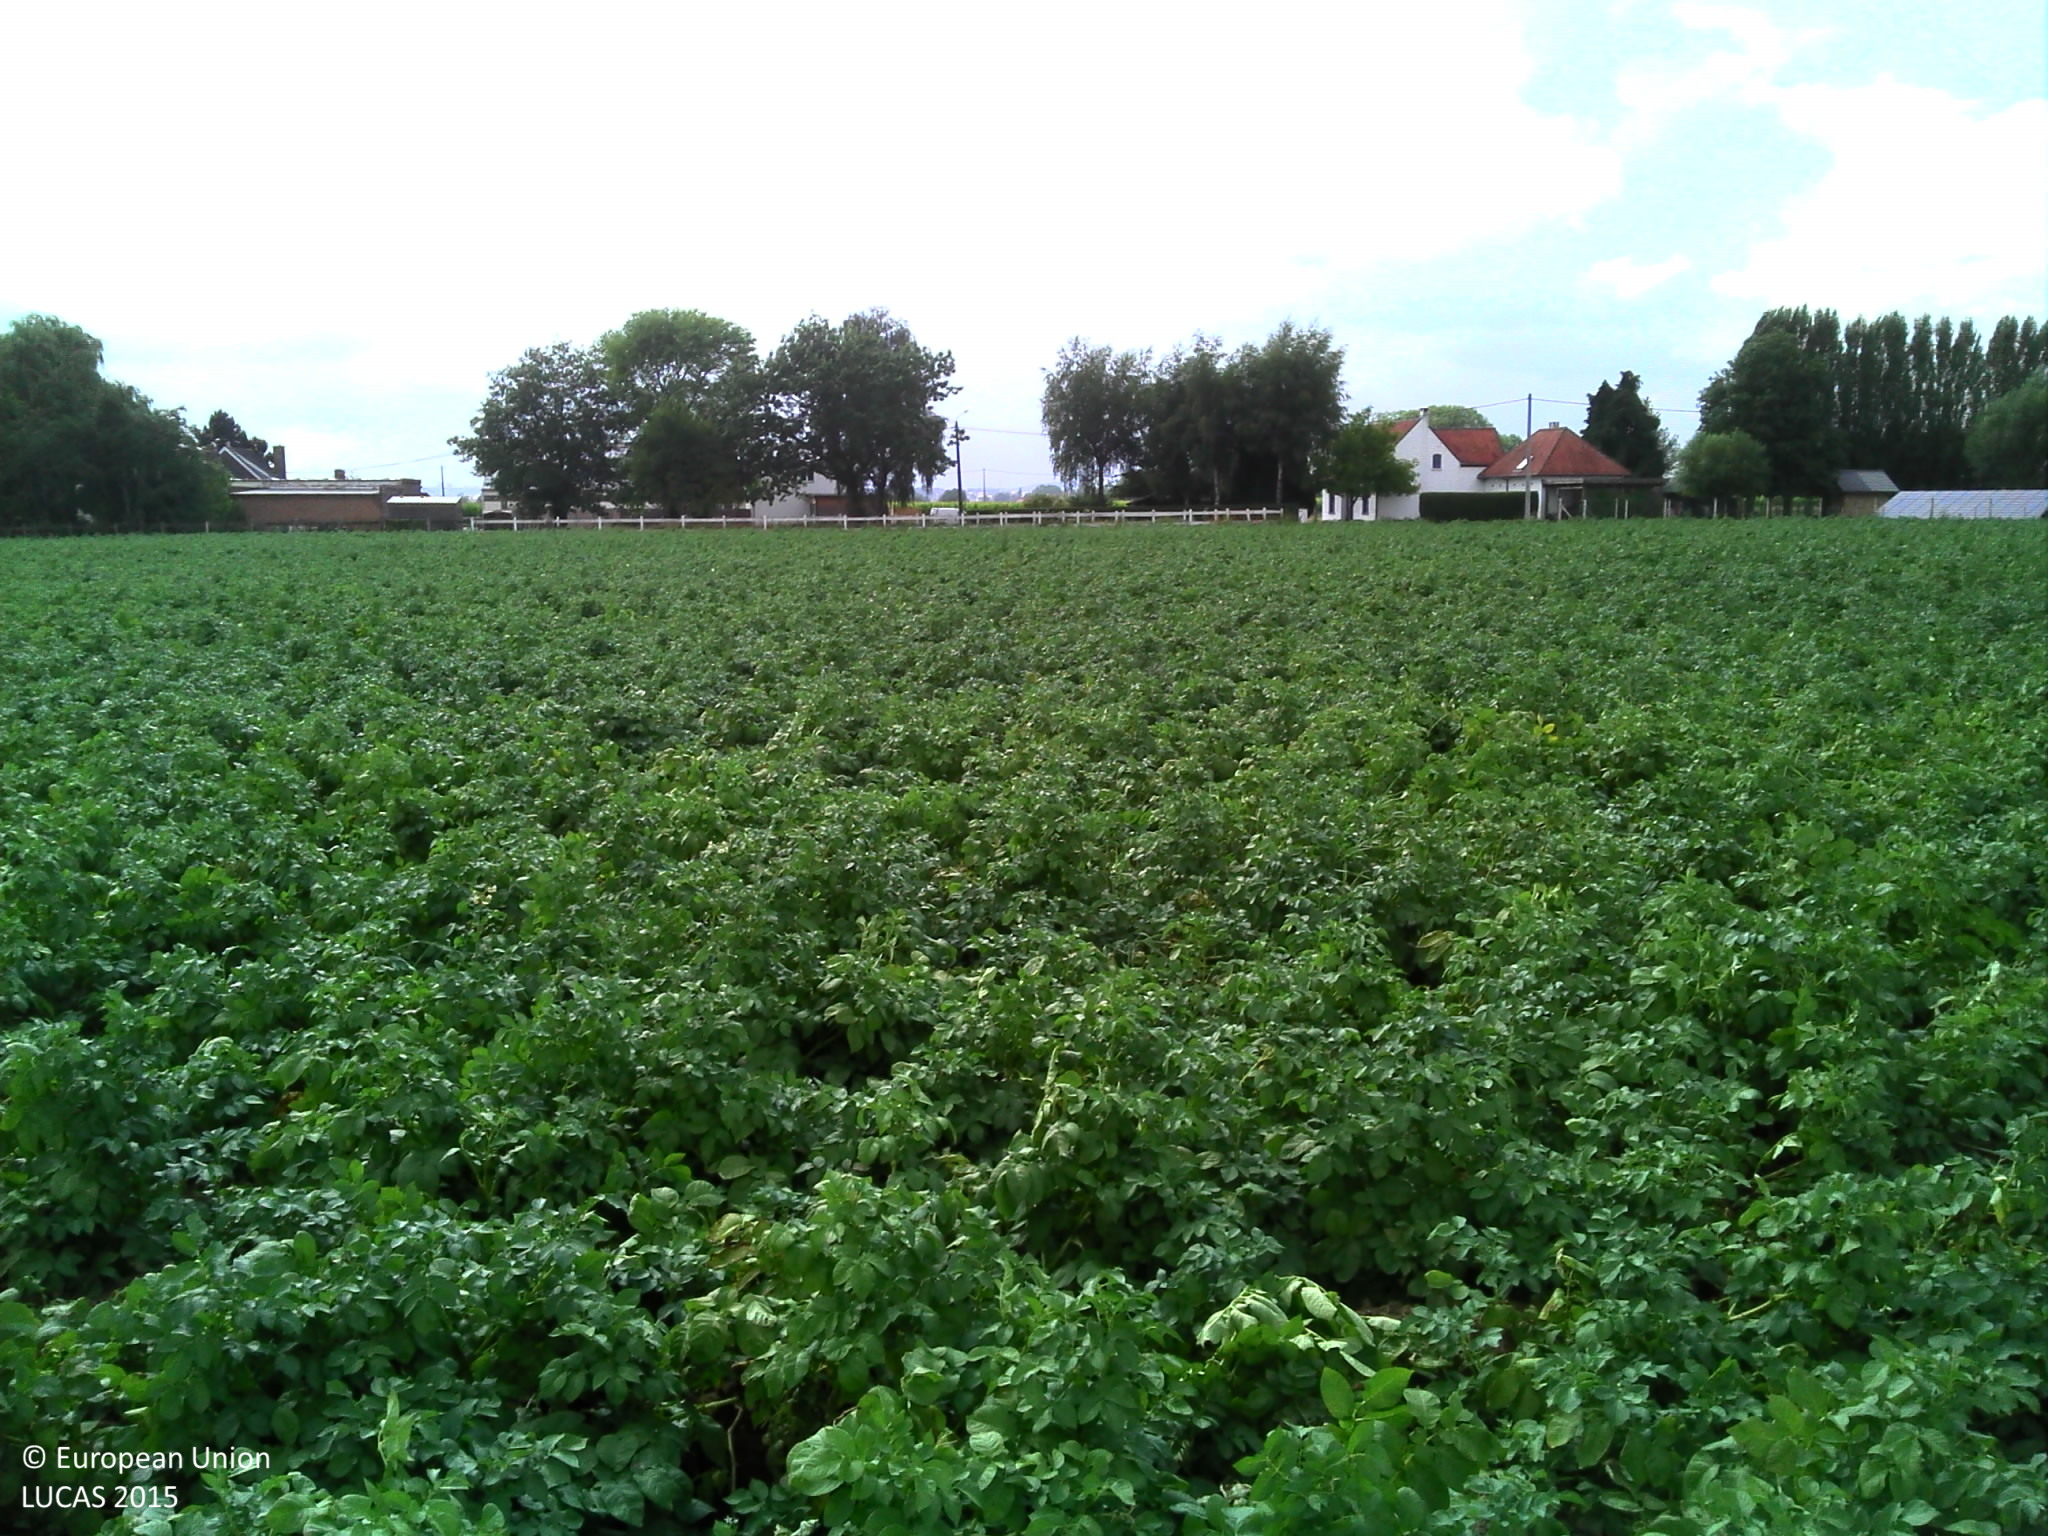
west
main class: Cropland
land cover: Potatoes
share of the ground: > 75 %
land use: Agriculture (excluding fallow land and kitchen gardens)
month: August
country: BE
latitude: 50.7794
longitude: 2.9695
